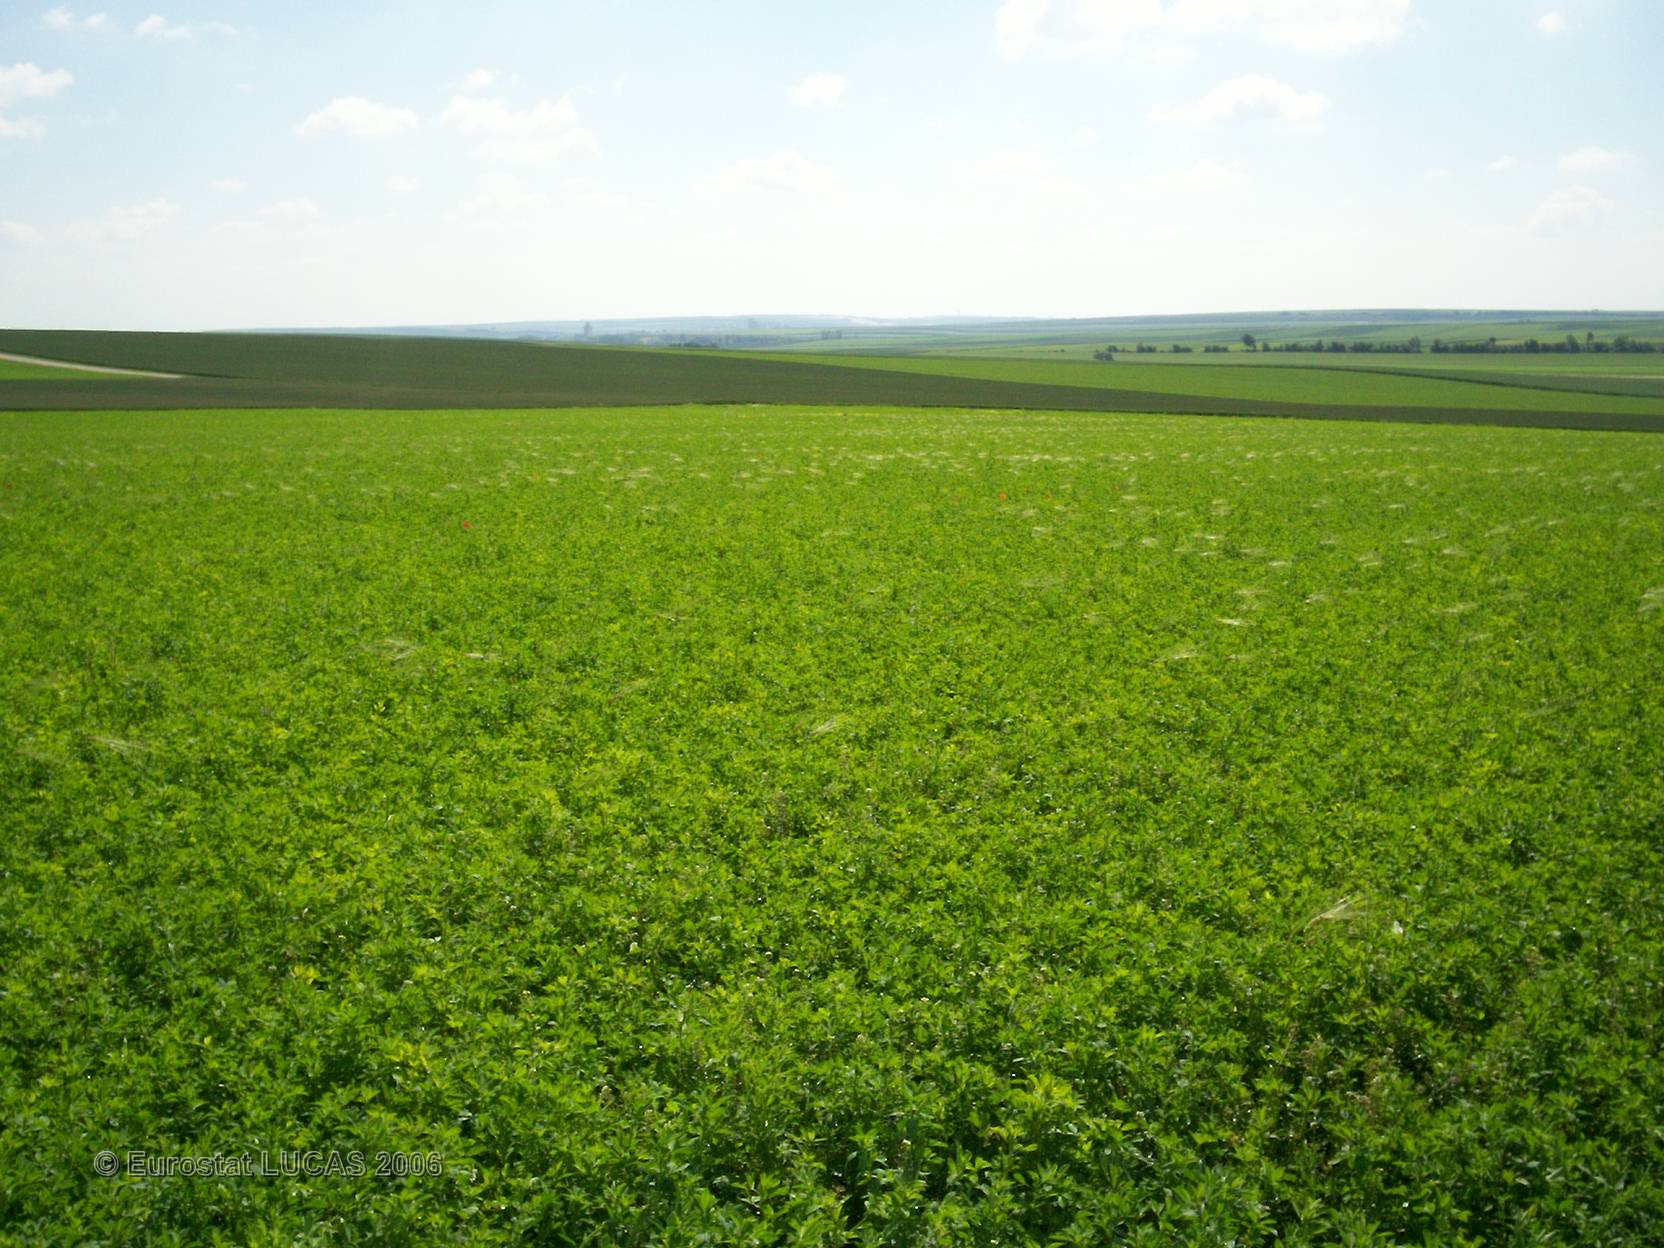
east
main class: Cropland
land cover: Lucerne
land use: Agriculture (excluding fallow land and kitchen gardens)
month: June
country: FR
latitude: 48.8040
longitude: 4.4280
